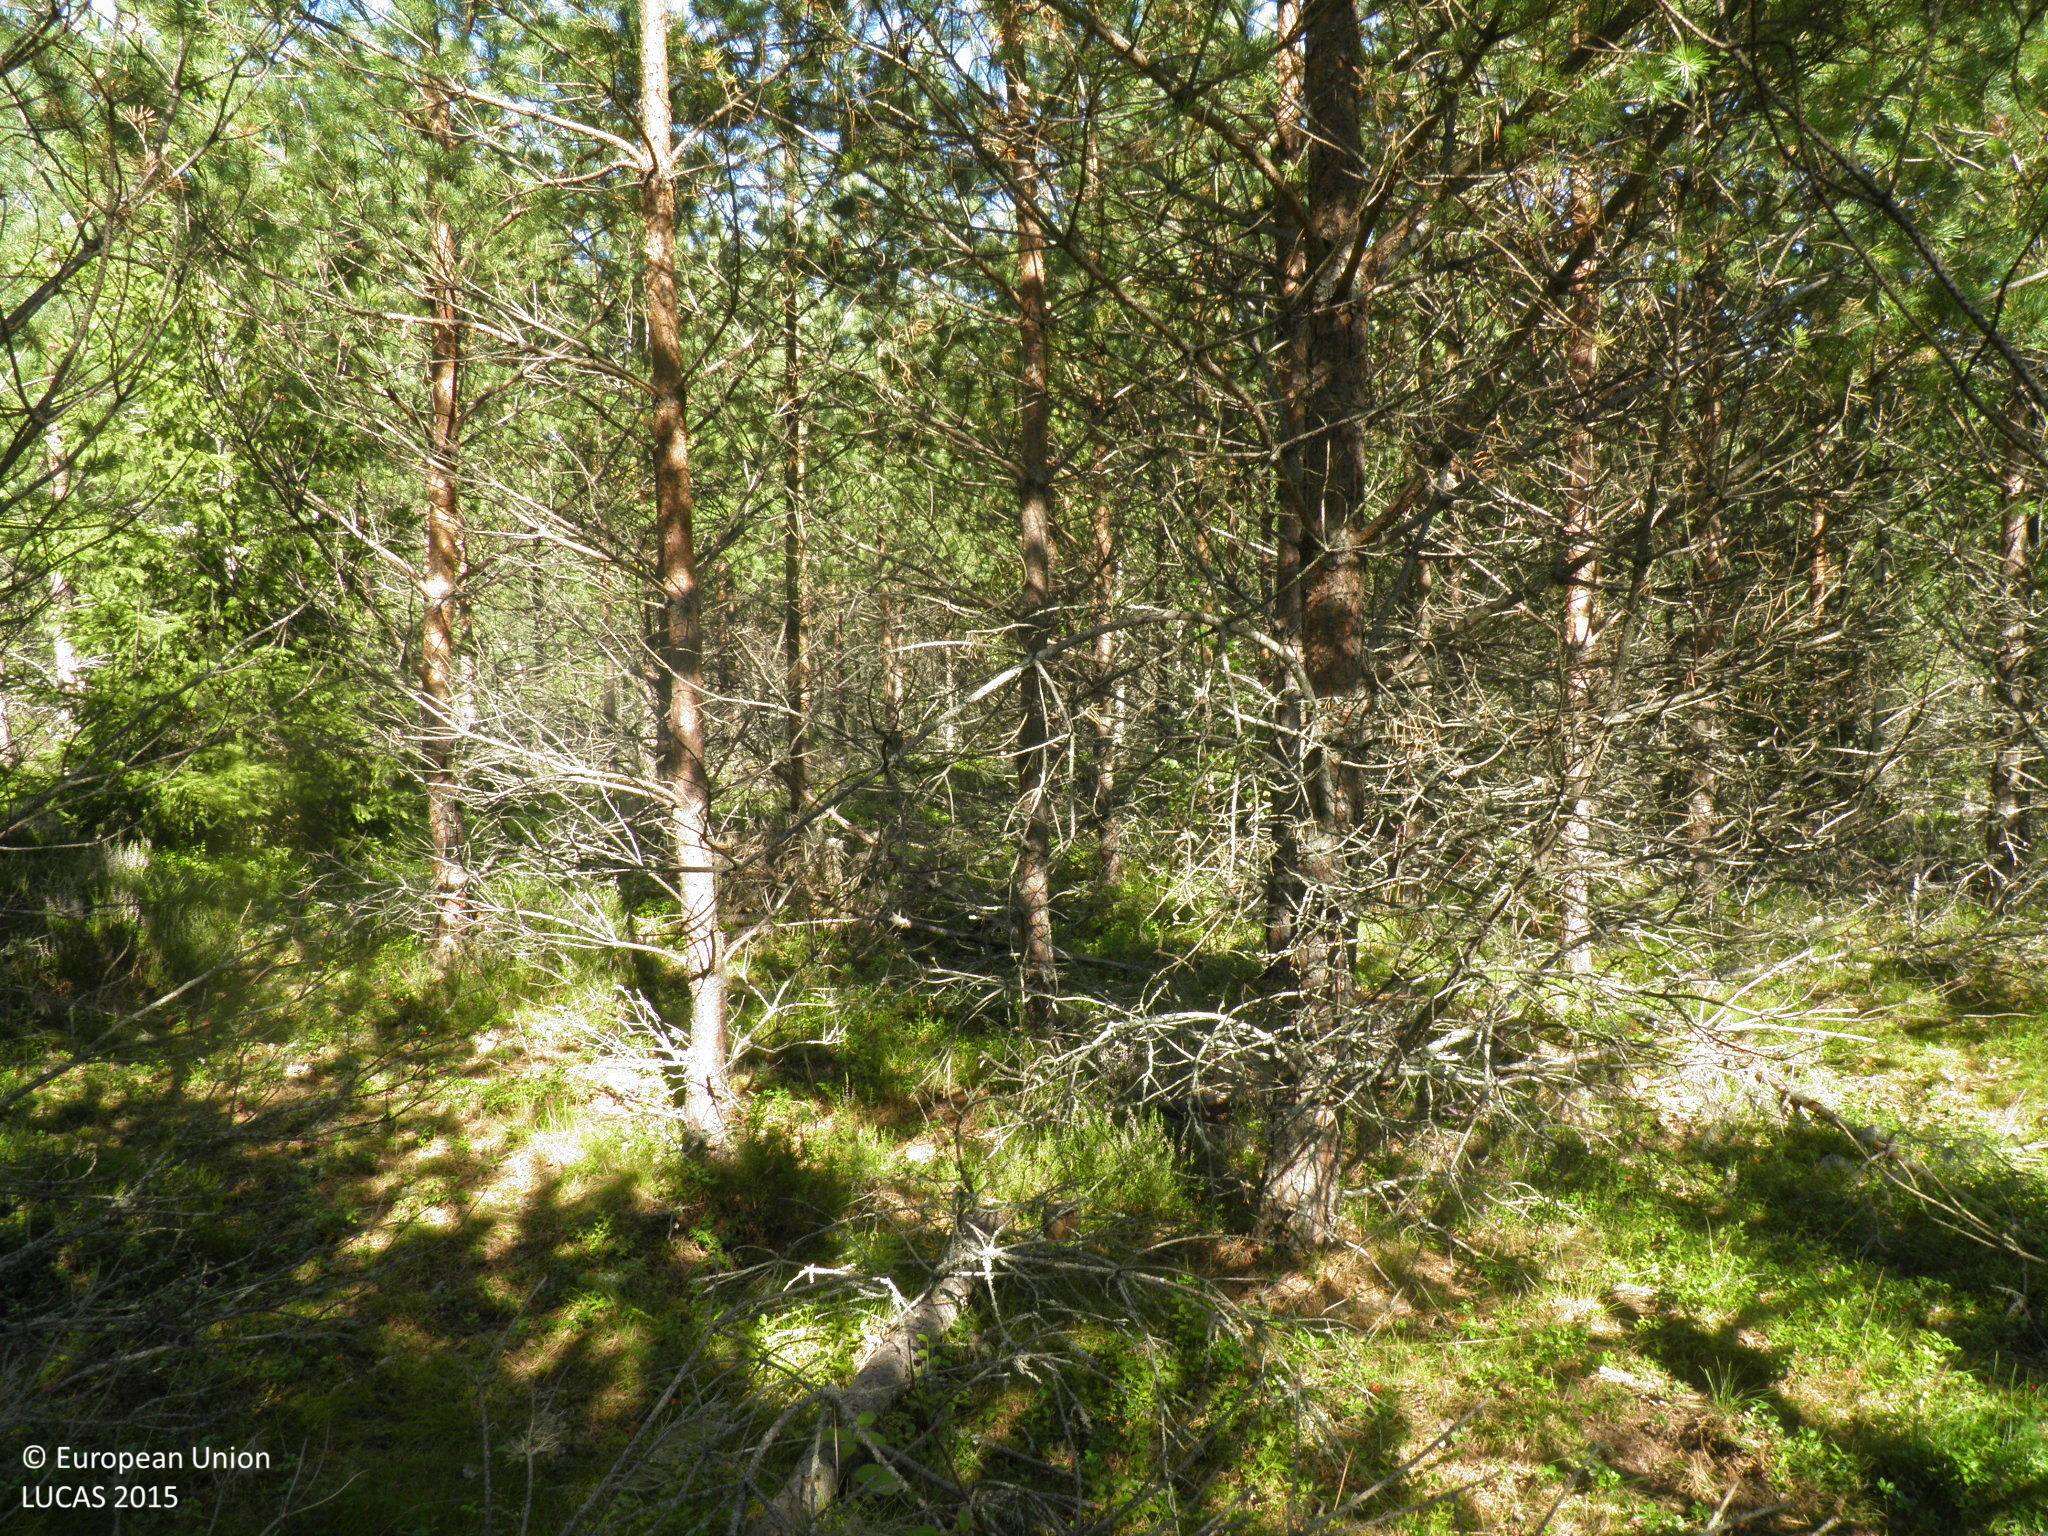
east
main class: Woodland
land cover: Pine dominated coniferous woodland
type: hemiboreal forest and nemoral coniferous forest and mixed broadleaved-coniferous forest
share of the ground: > 75 %
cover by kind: coniferous forest trees 80 %, shrubs 10 %, herbaceous plants 10 %
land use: Forestry
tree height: < 5 m
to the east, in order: Pine dominated coniferous woodland; Pine dominated mixed woodland; Ditches and canals; Grass margins; Barley
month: August
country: FI
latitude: 60.8107
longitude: 21.6183
